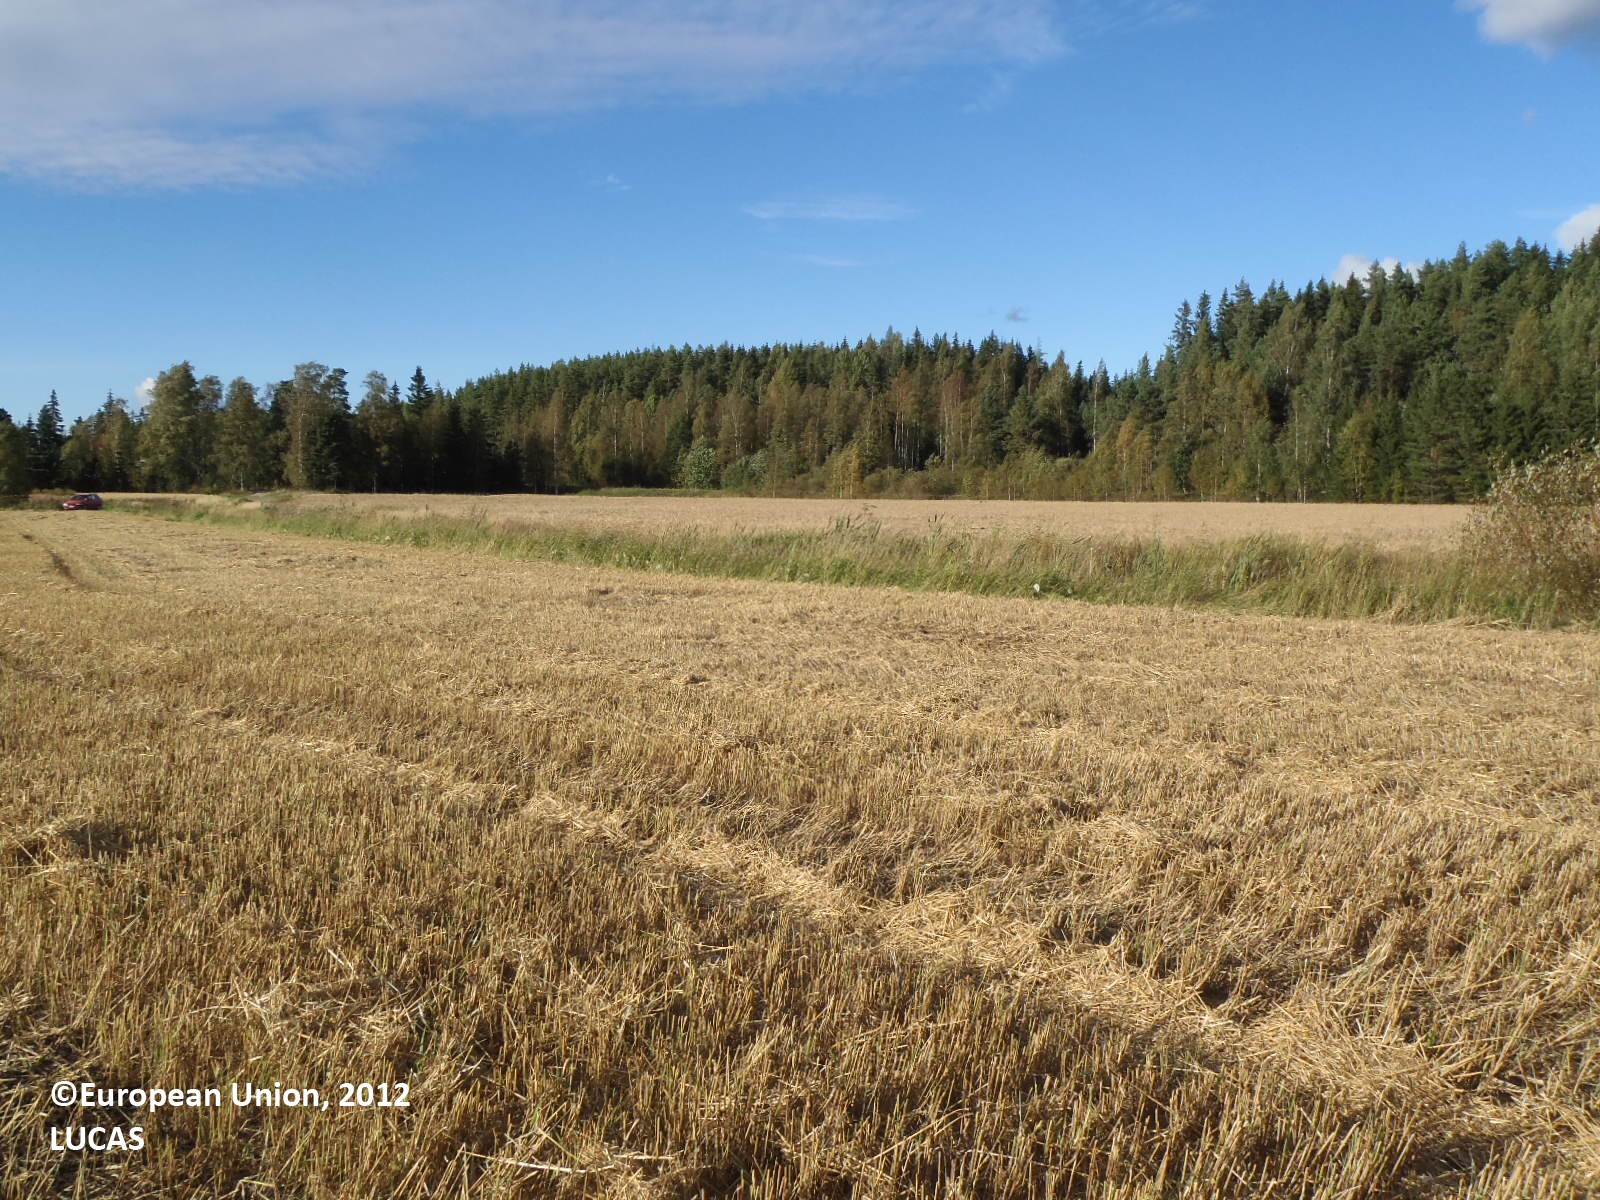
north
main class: Cropland
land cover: Barley
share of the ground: > 75 %
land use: Agriculture (excluding fallow land and kitchen gardens)
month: September
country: FI
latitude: 61.3189
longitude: 22.5235
